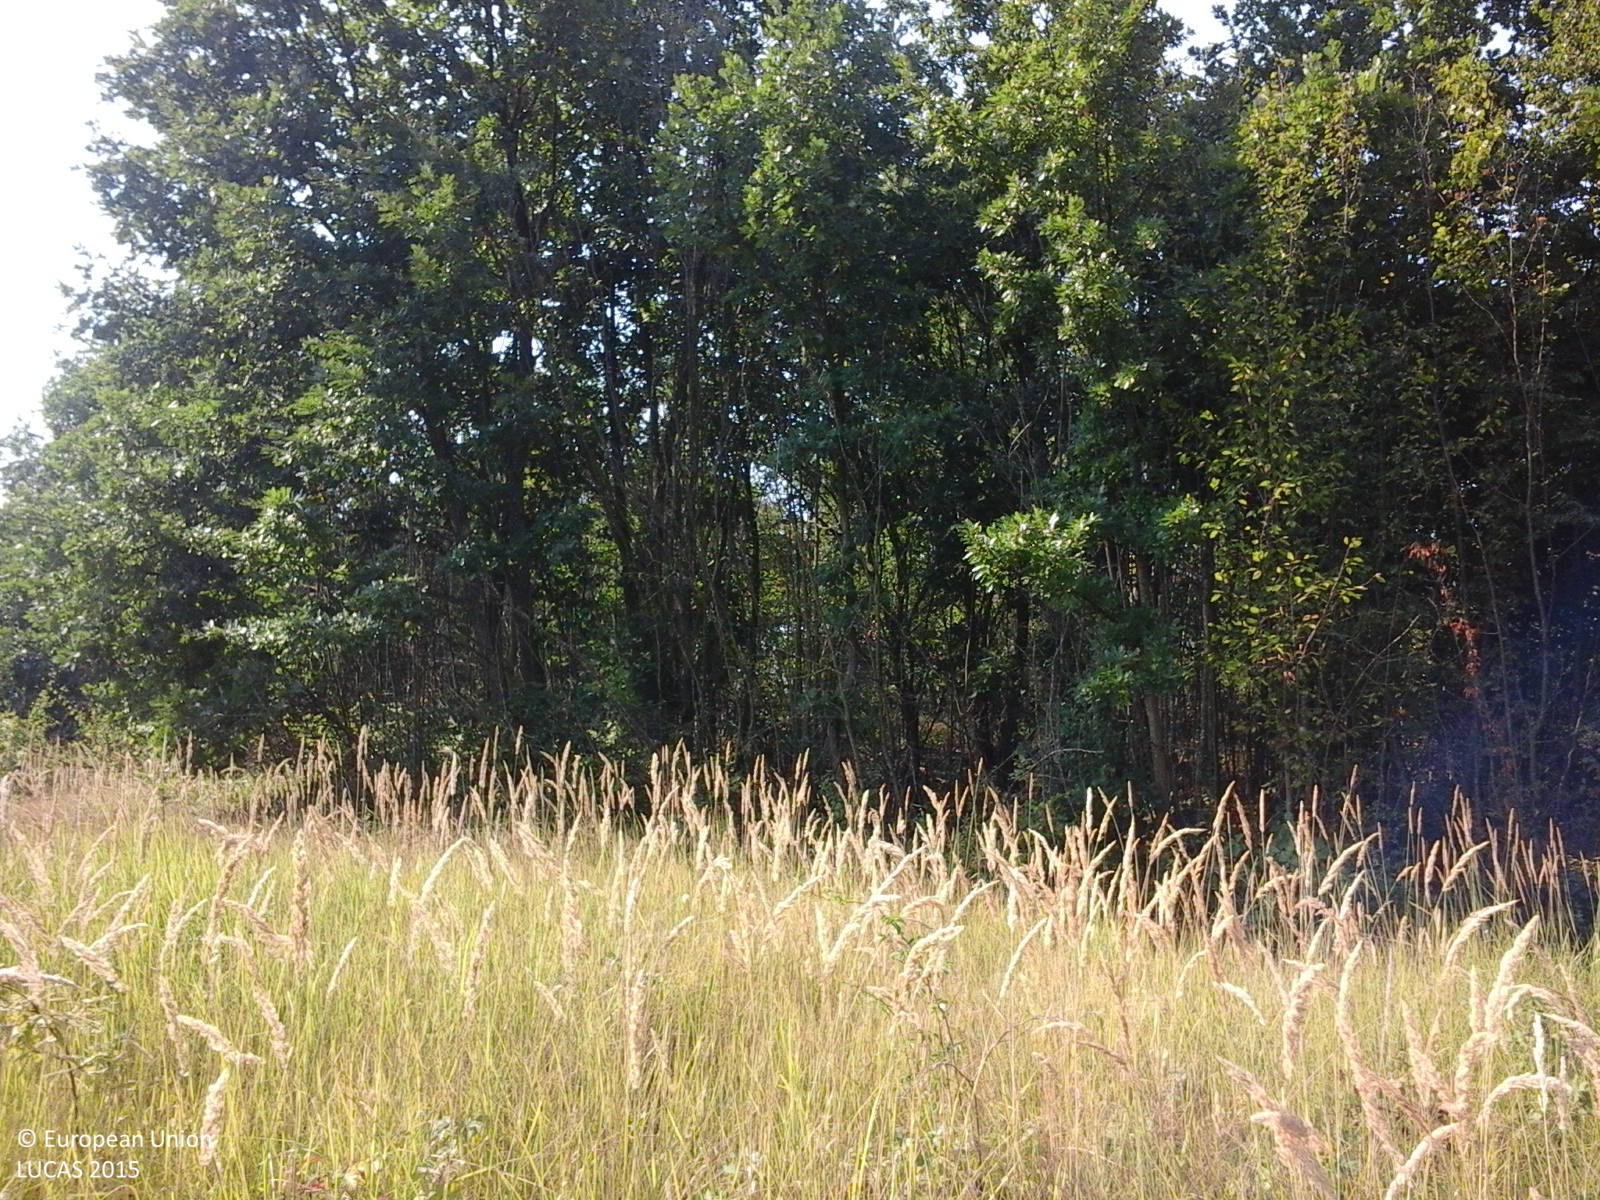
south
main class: Grassland
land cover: Spontaneously vegetated surfaces
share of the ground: > 75 %
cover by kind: herbaceous plants 100 %
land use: Semi-natural and natural areas not in use
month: August
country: RO
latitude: 46.2802
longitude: 22.1011
